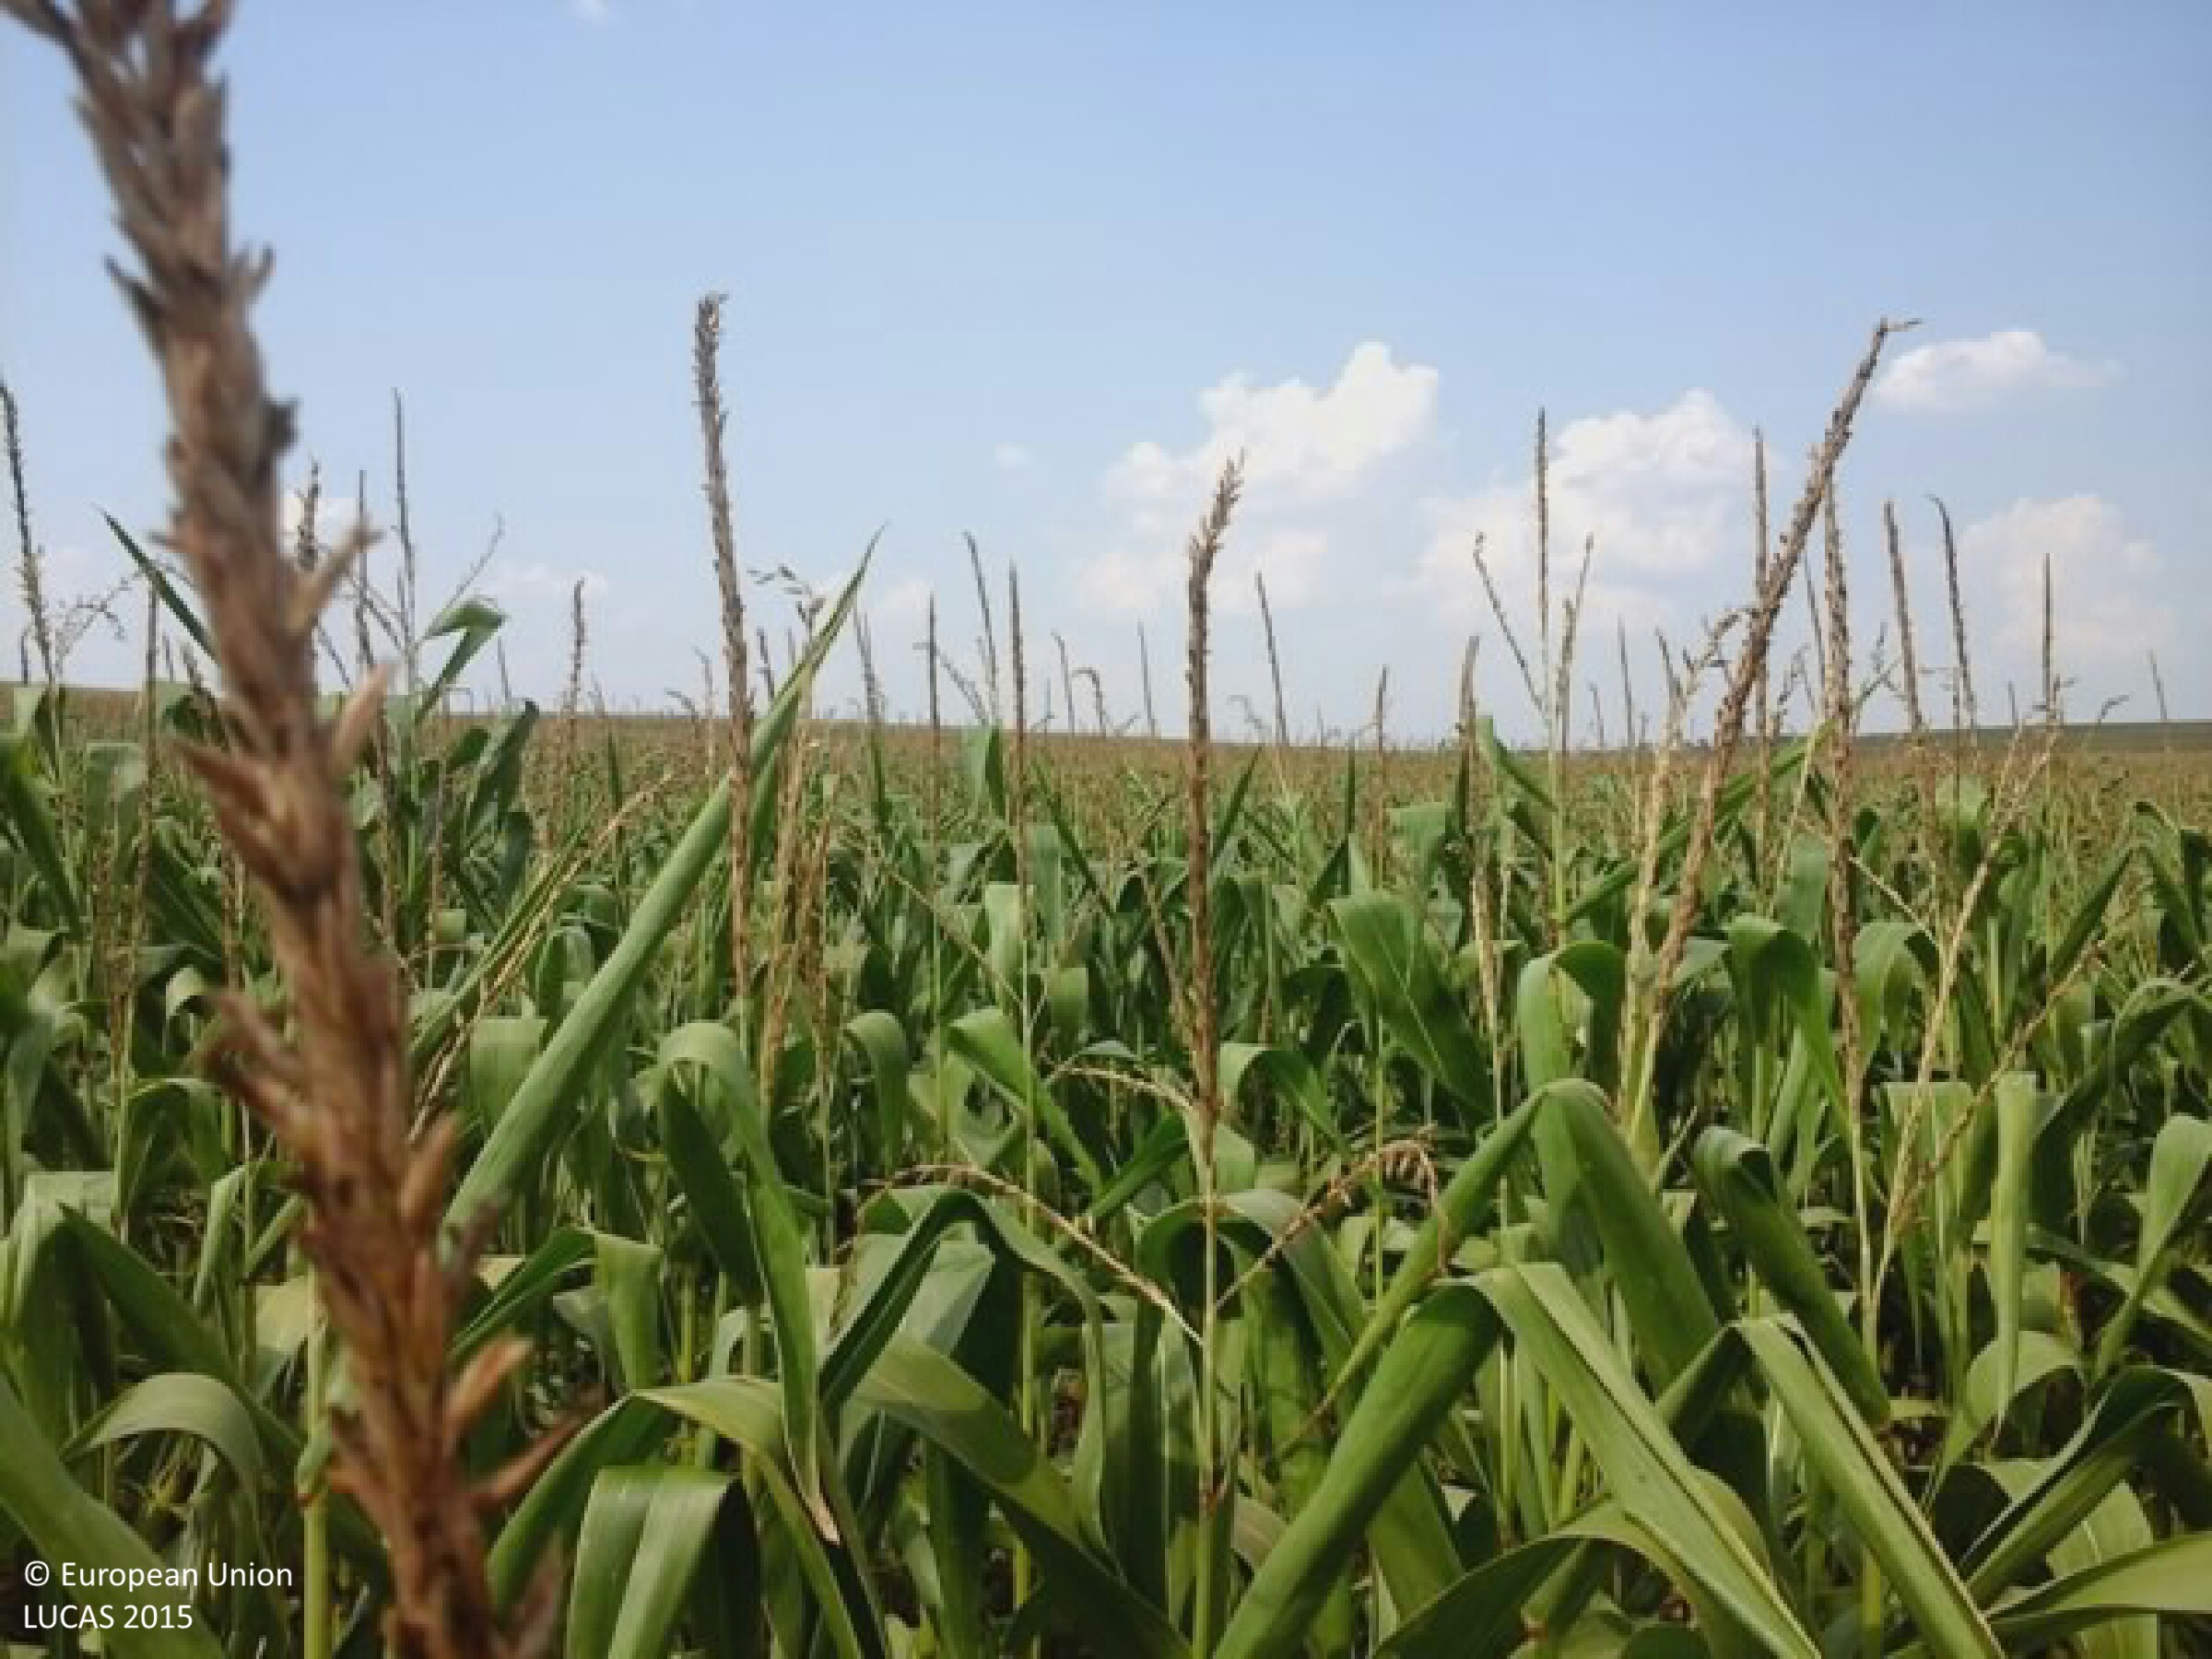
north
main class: Cropland
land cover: Maize
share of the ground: > 75 %
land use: Agriculture (excluding fallow land and kitchen gardens)
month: August
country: HU
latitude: 46.3233
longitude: 18.2296
